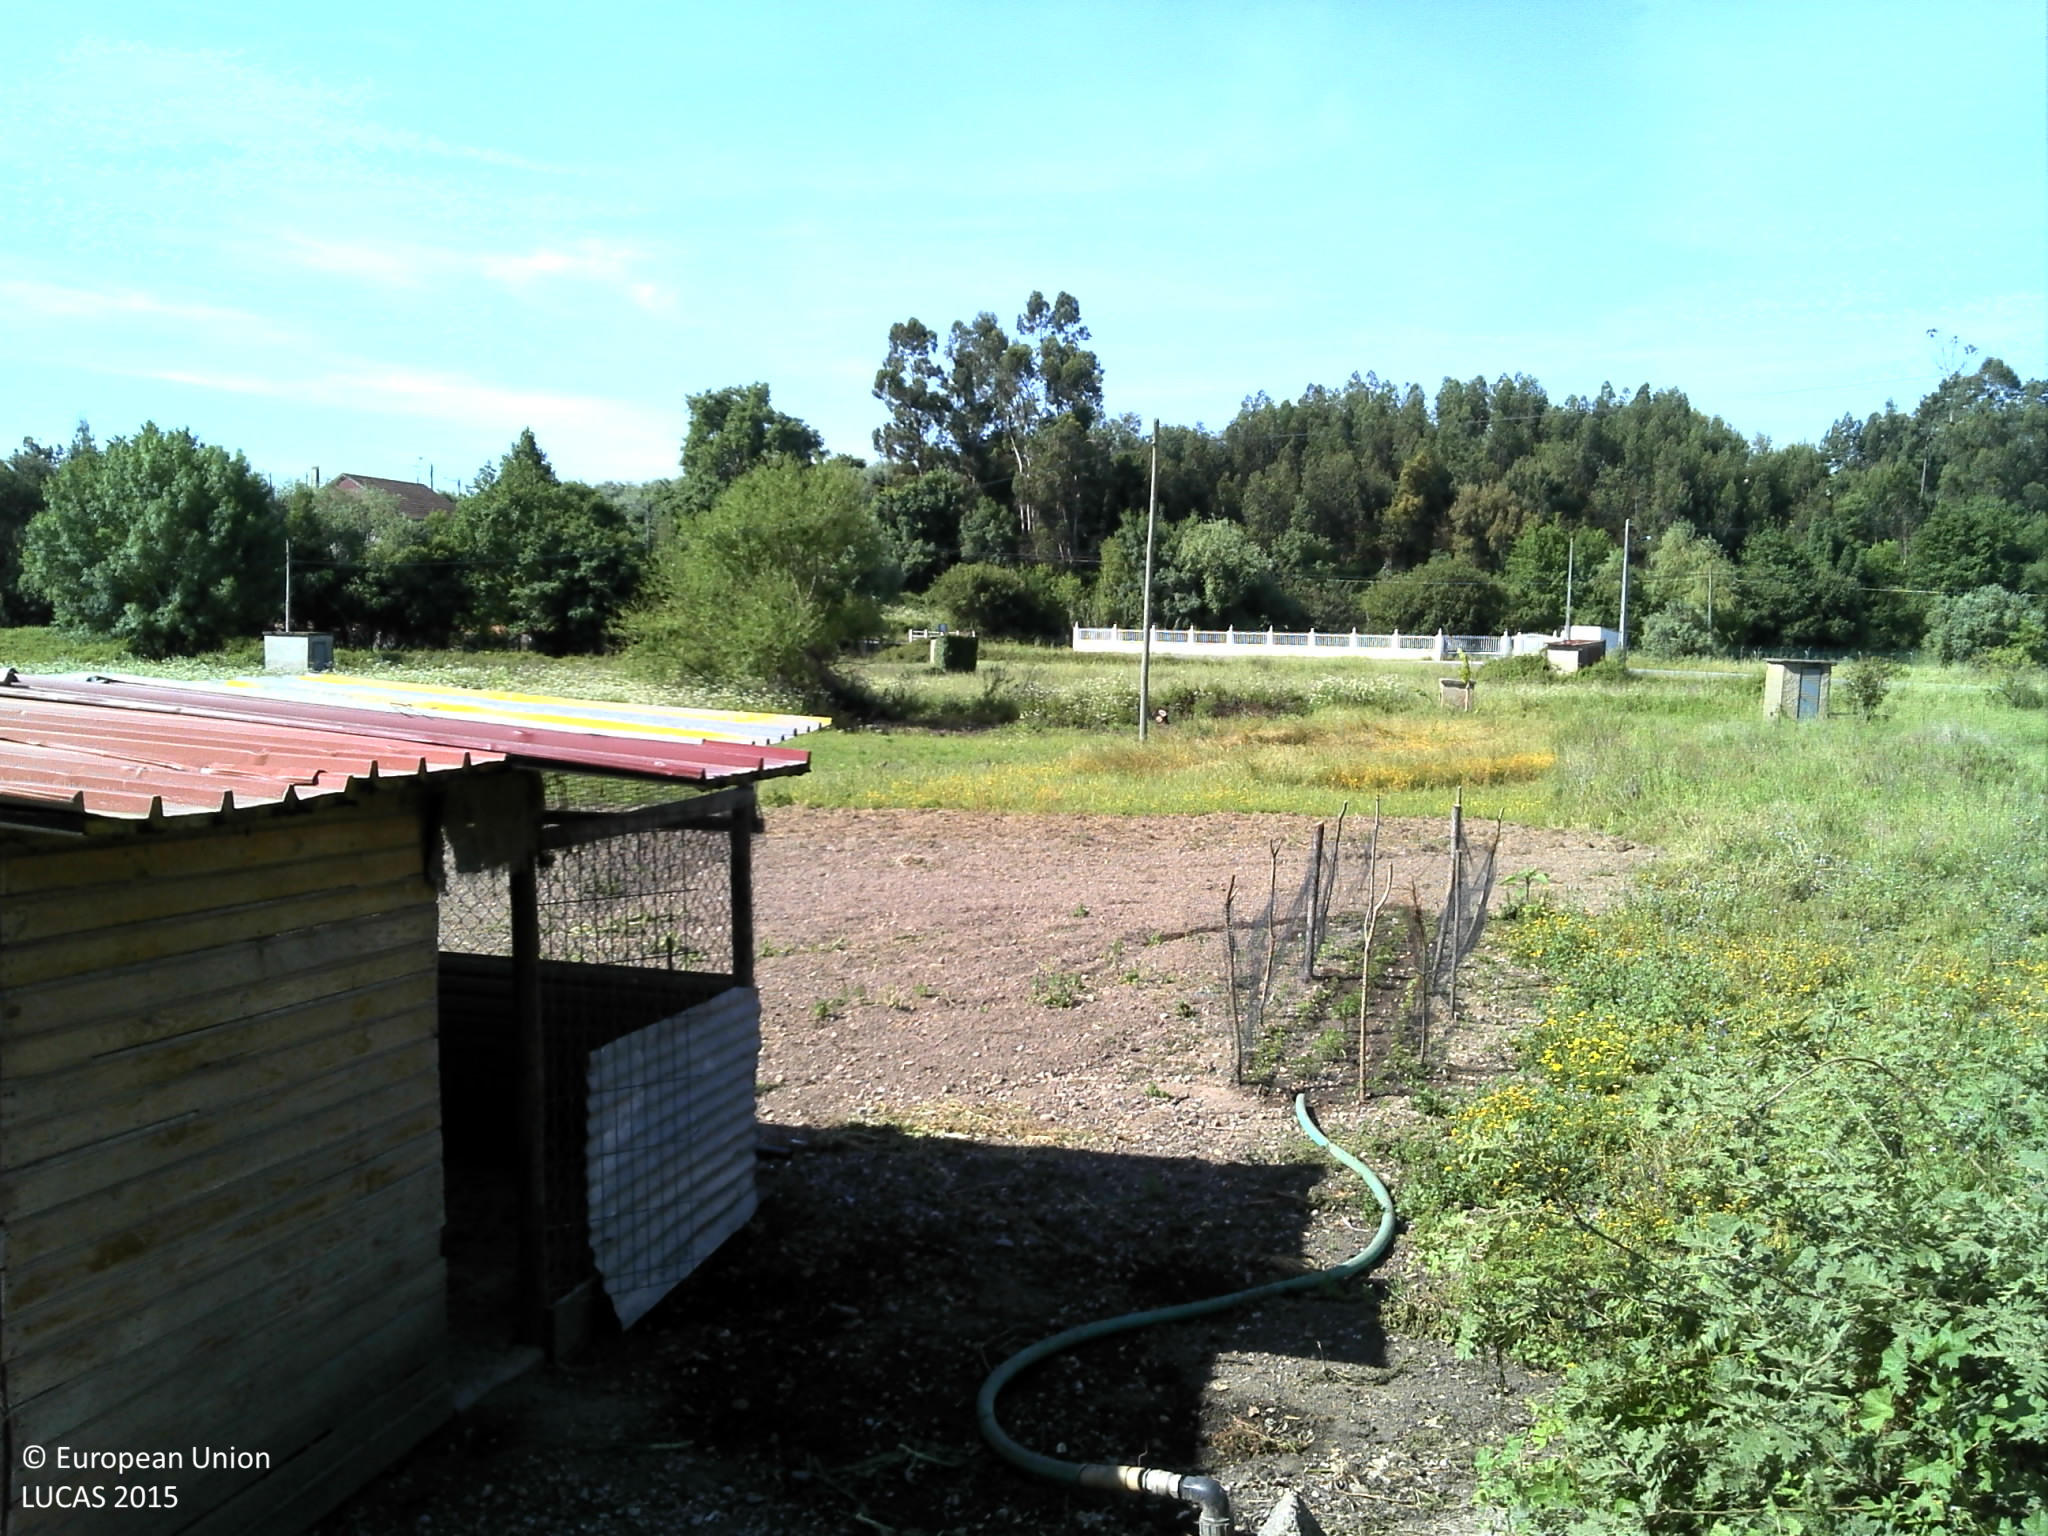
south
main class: Cropland
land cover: Potatoes
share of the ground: > 75 %
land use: Agriculture (excluding fallow land and kitchen gardens)
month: May
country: PT
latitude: 39.7565
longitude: -8.4595
